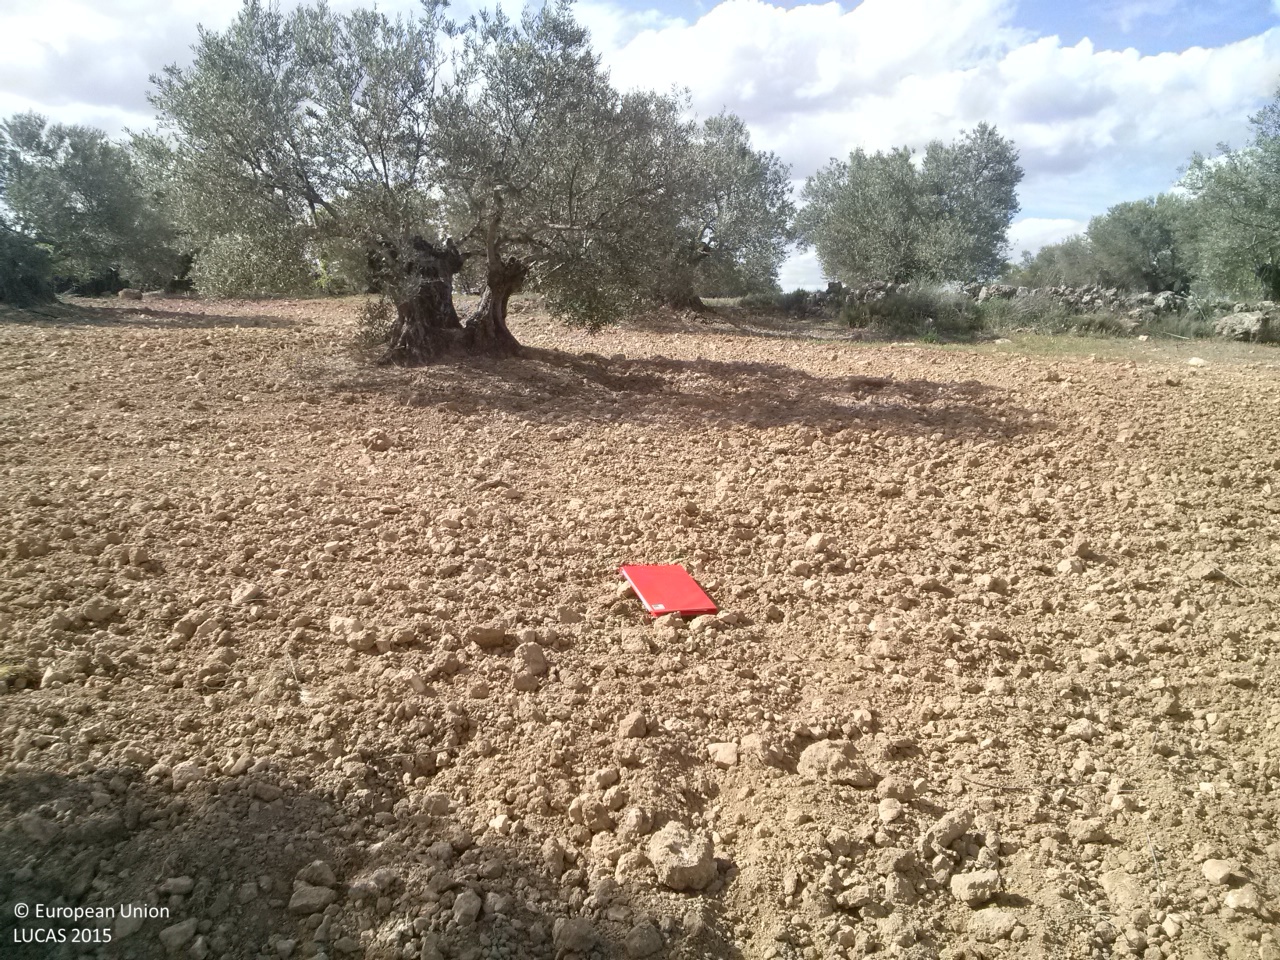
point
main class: Cropland
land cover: Olive groves
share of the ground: 10 - 25 %
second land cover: Other bare soil
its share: > 75 %
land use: Agriculture (excluding fallow land and kitchen gardens)
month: May
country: ES
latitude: 39.7872
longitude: -2.8288
